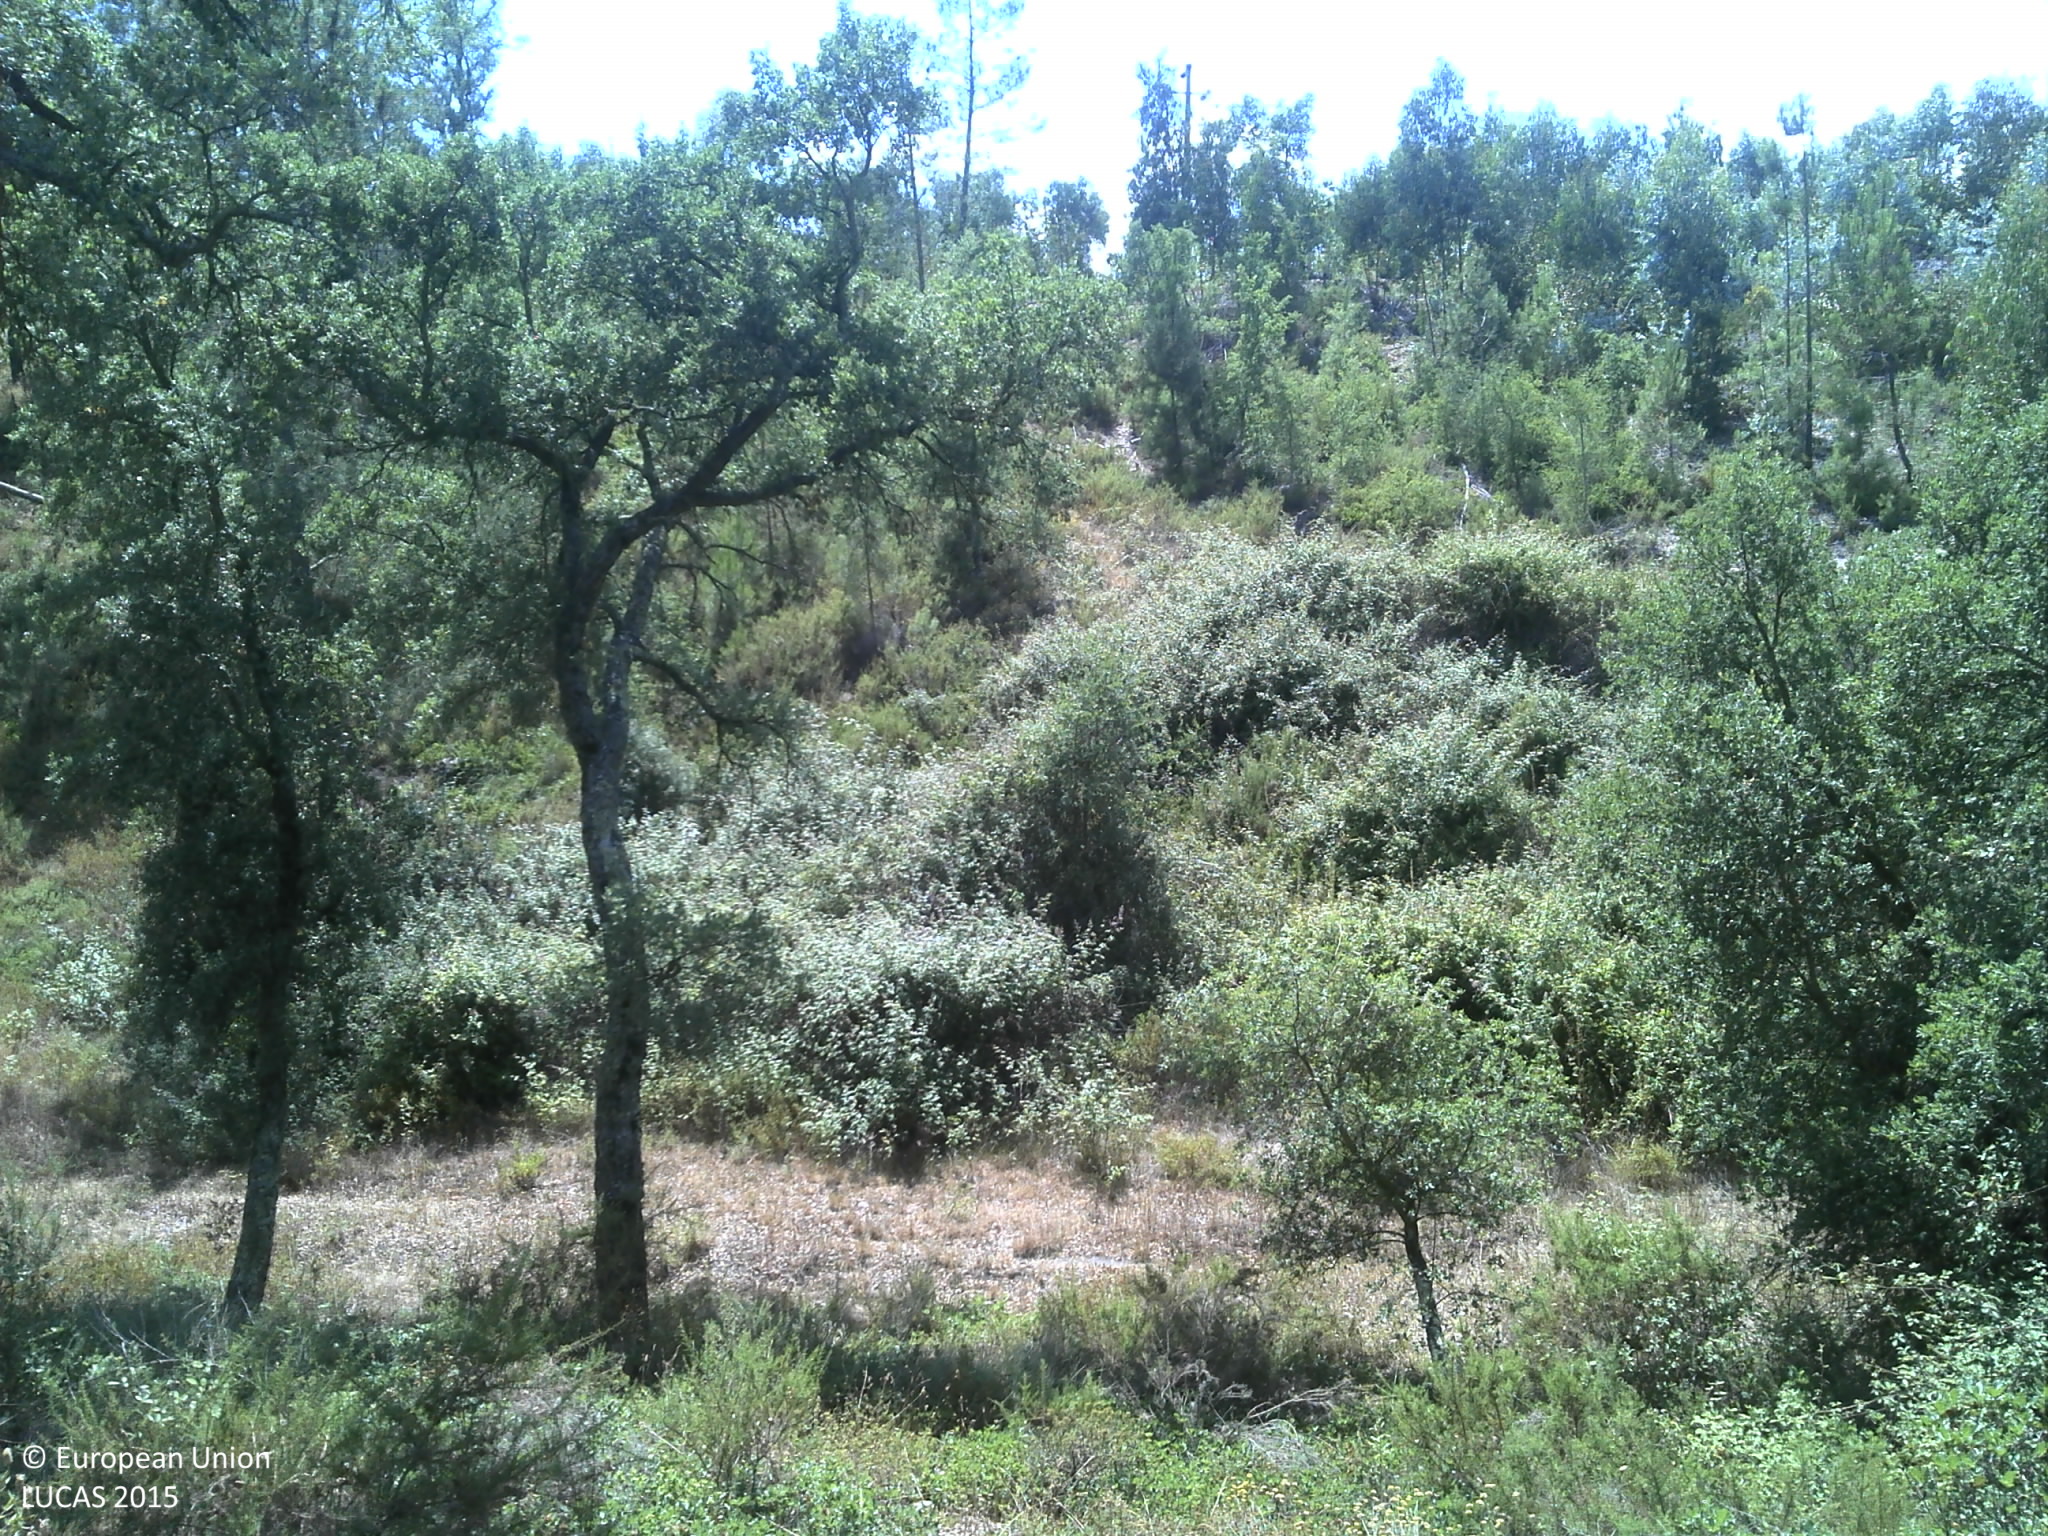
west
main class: Woodland
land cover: Broadleaved woodland
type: broadleaved evergreen forest
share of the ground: 25 - 50 %
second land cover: Grassland without tree/shrub cover
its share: 25 - 50 %
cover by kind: broadleaved forest trees 50 %, unconsolidated bare surface 20 %, shrubs 15 %, herbaceous plants 15 %
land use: Forestry
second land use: Agriculture (excluding fallow land and kitchen gardens)
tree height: > 5 m
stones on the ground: 10 - 25 %
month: June
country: PT
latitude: 39.2832
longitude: -8.2274
